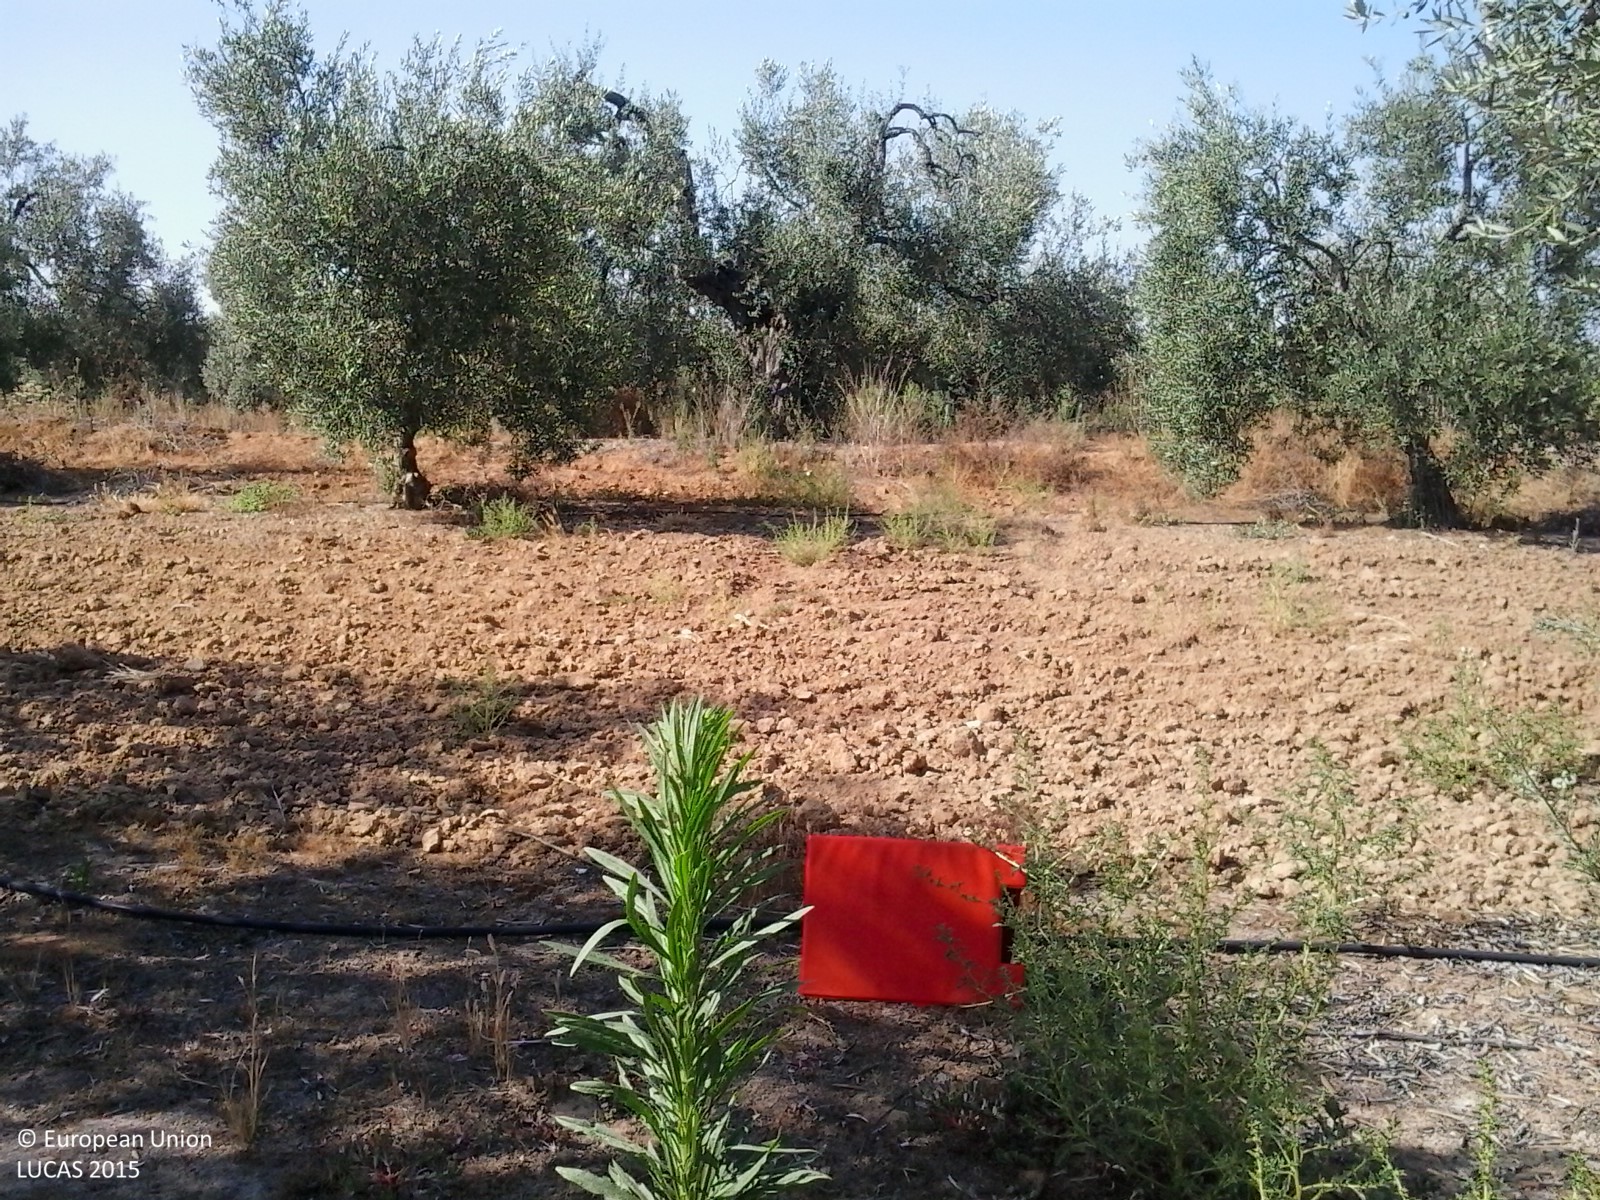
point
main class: Cropland
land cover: Olive groves
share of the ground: 25 - 50 %
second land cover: Other bare soil
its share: > 75 %
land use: Agriculture (excluding fallow land and kitchen gardens)
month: June
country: ES
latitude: 37.3627
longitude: -6.4135
